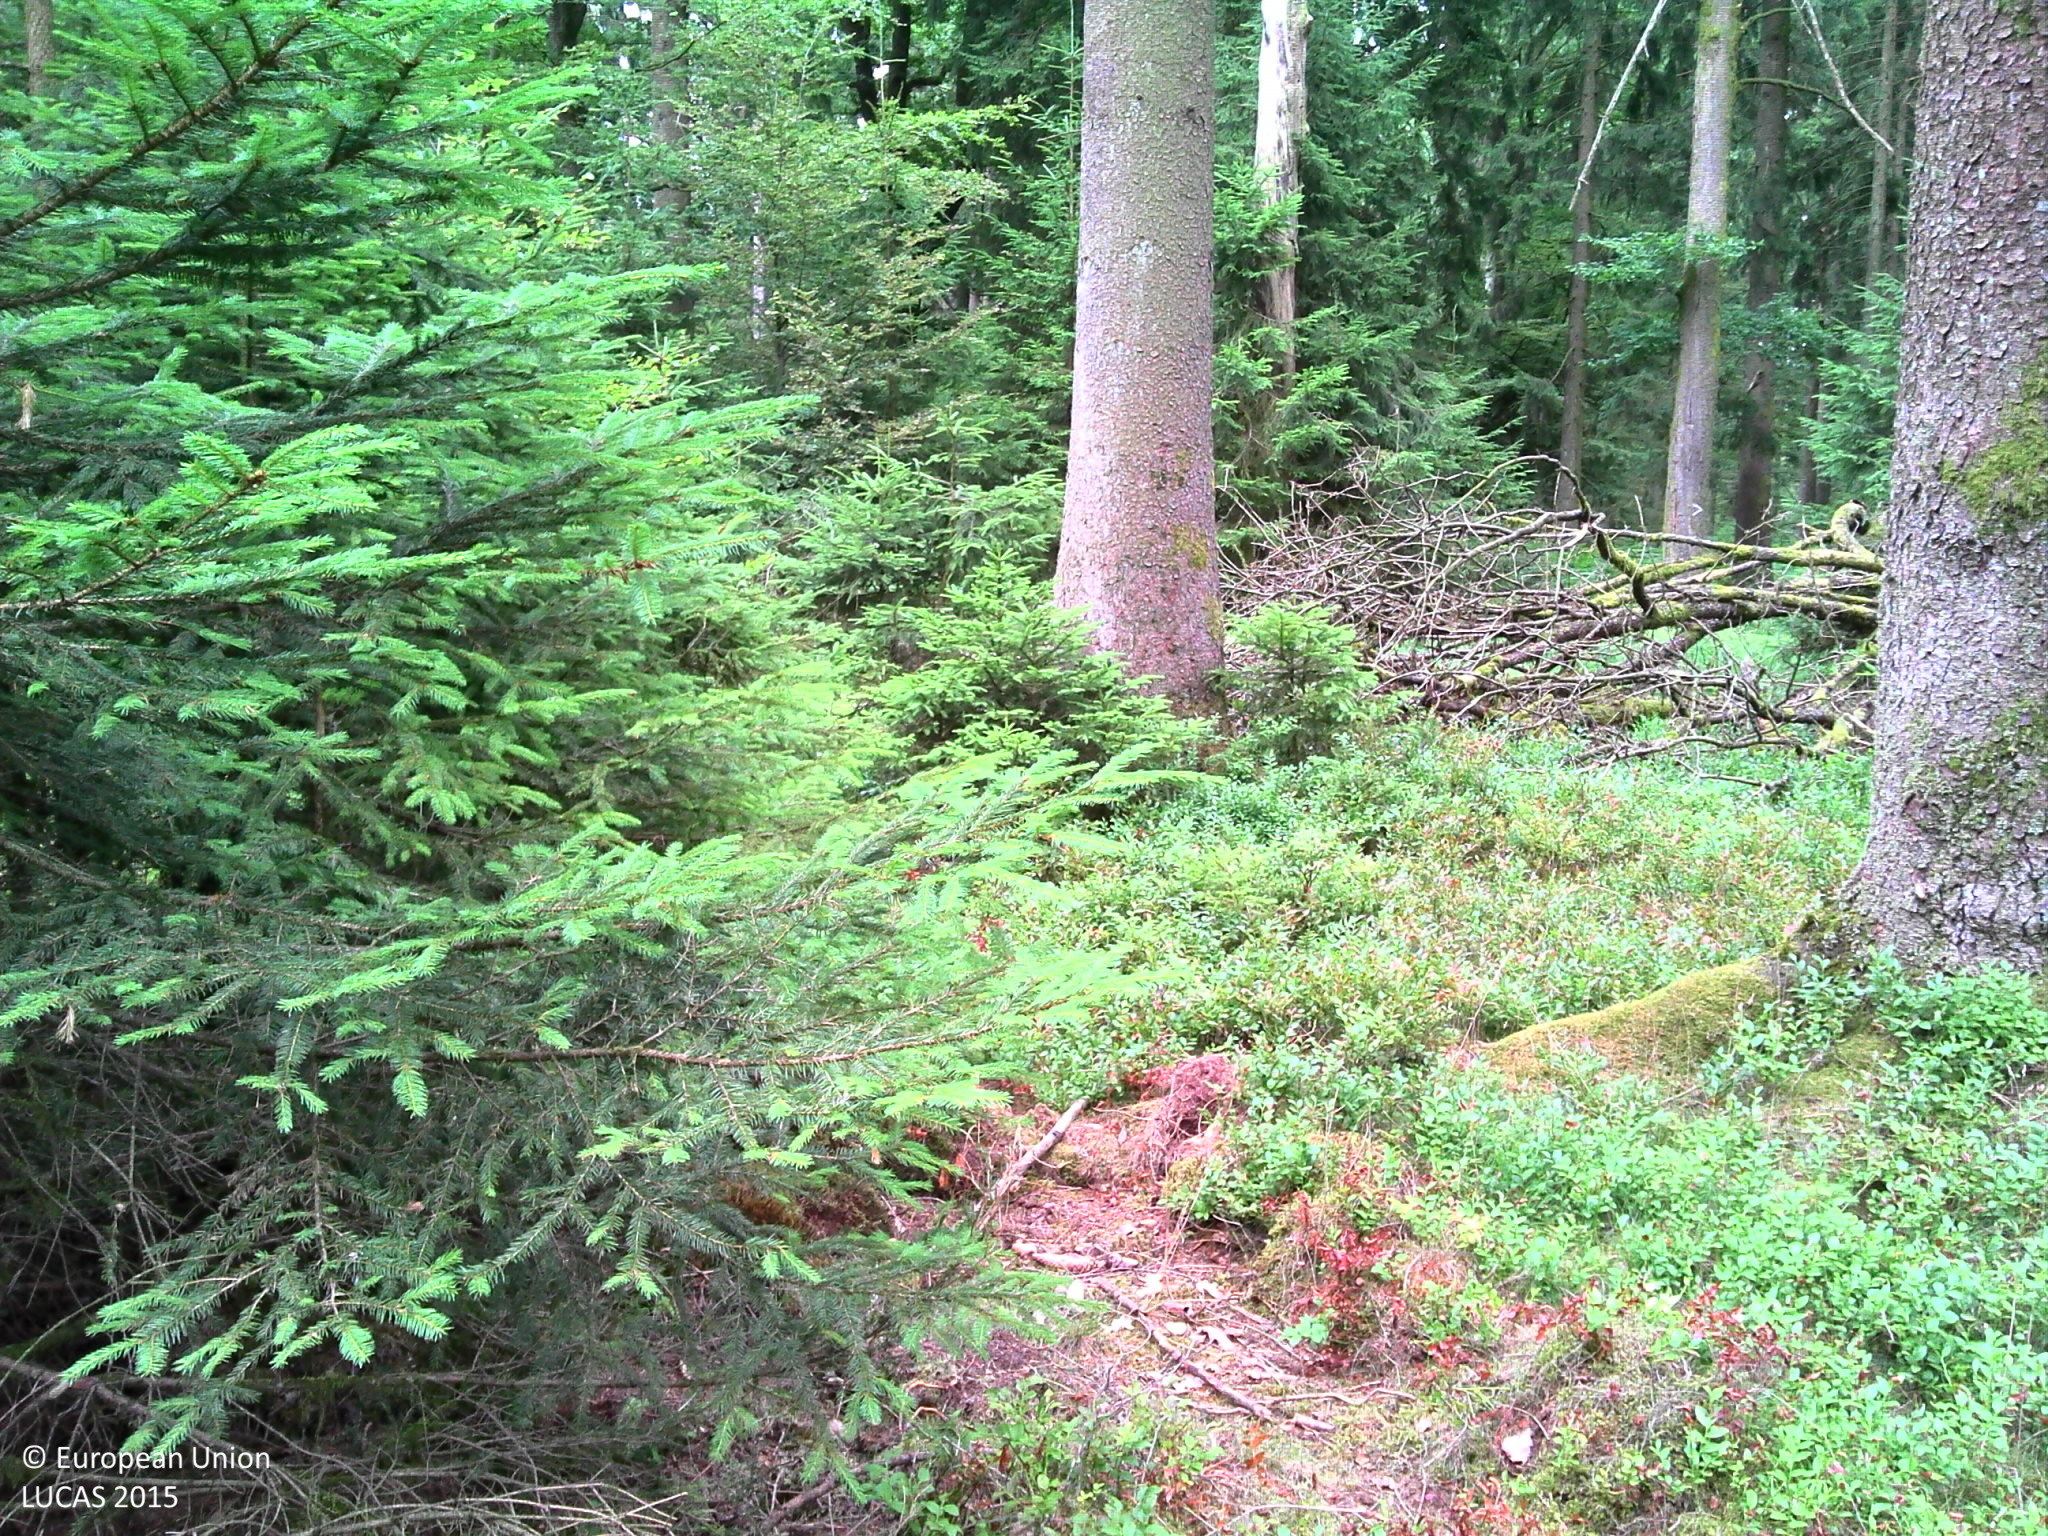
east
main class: Woodland
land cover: Spruce dominated coniferous woodland
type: hemiboreal forest and nemoral coniferous forest and mixed broadleaved-coniferous forest
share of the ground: 50 - 75 %
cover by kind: coniferous forest trees 60 %, herbaceous plants 20 %, shrubs 10 %, unconsolidated bare surface 10 %
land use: Forestry
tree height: > 5 m
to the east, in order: Spruce dominated coniferous woodland; Tracks; Spruce dominated coniferous woodland; Broadleaved woodland
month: July
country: BE
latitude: 49.7571
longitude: 5.5983
